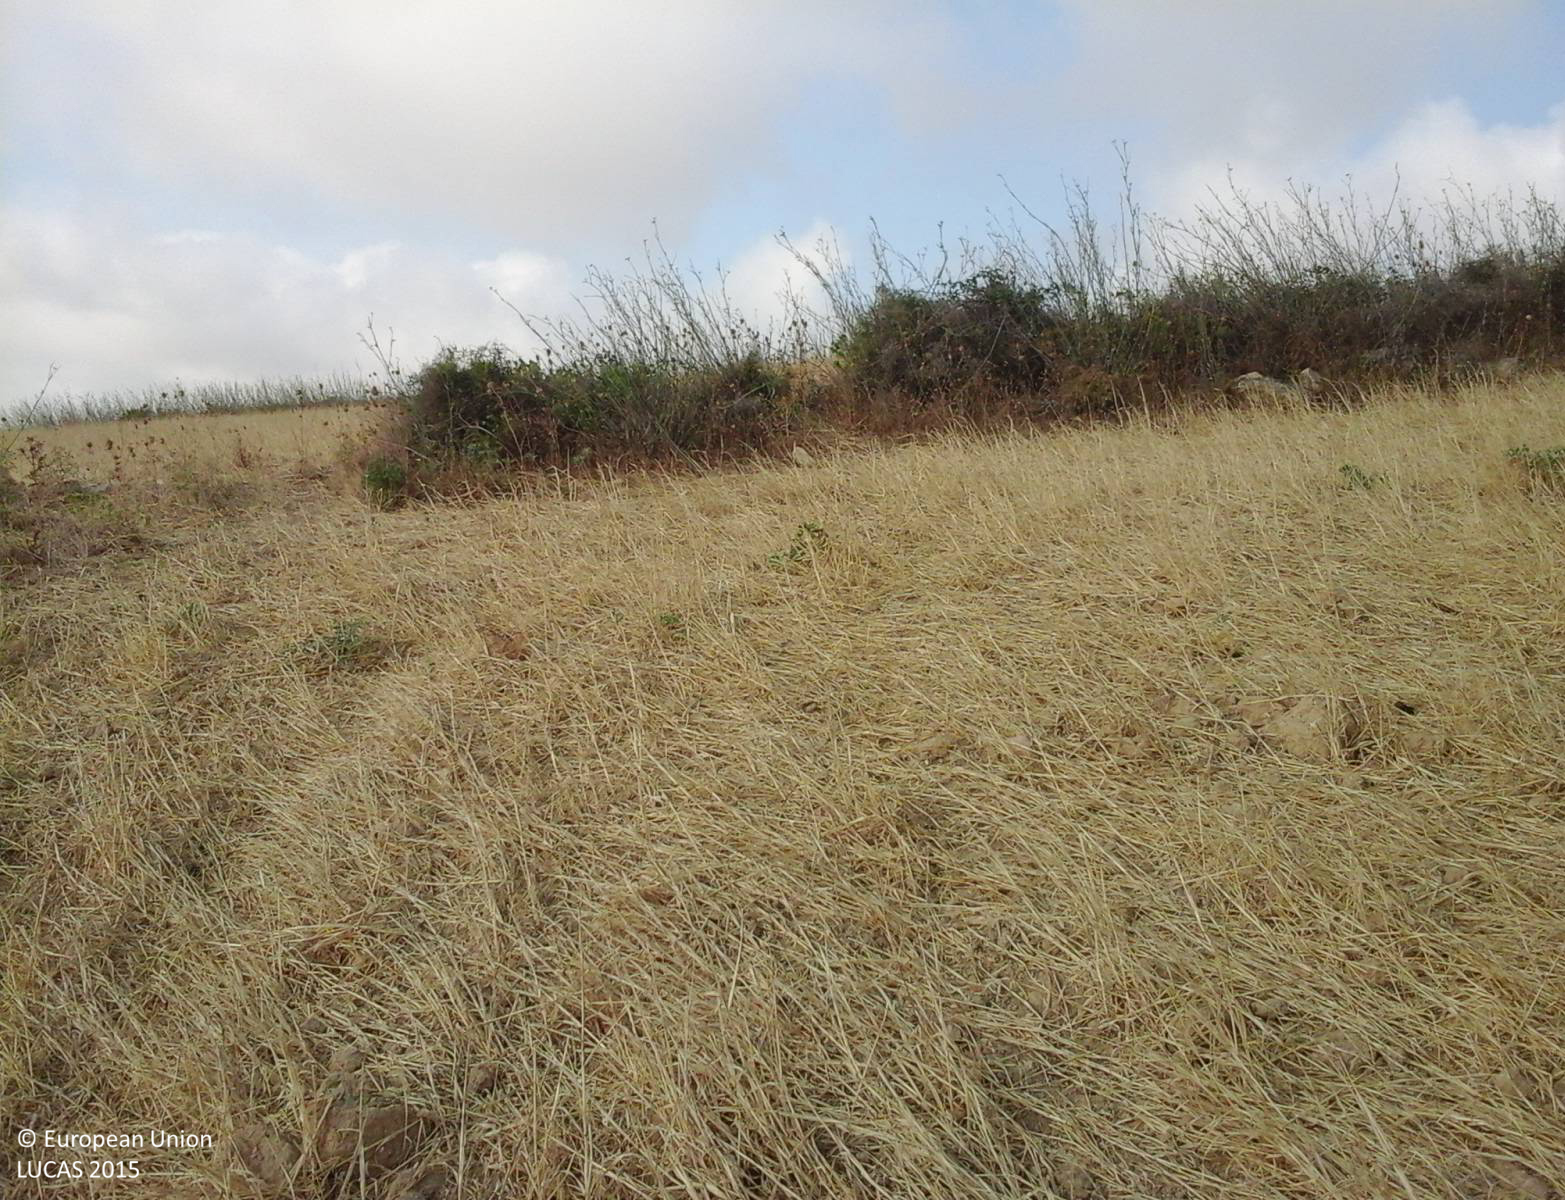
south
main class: Cropland
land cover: Mixed cereals for fodder
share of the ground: > 75 %
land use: Agriculture (excluding fallow land and kitchen gardens)
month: July
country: IT
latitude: 39.6089
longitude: 8.8768
